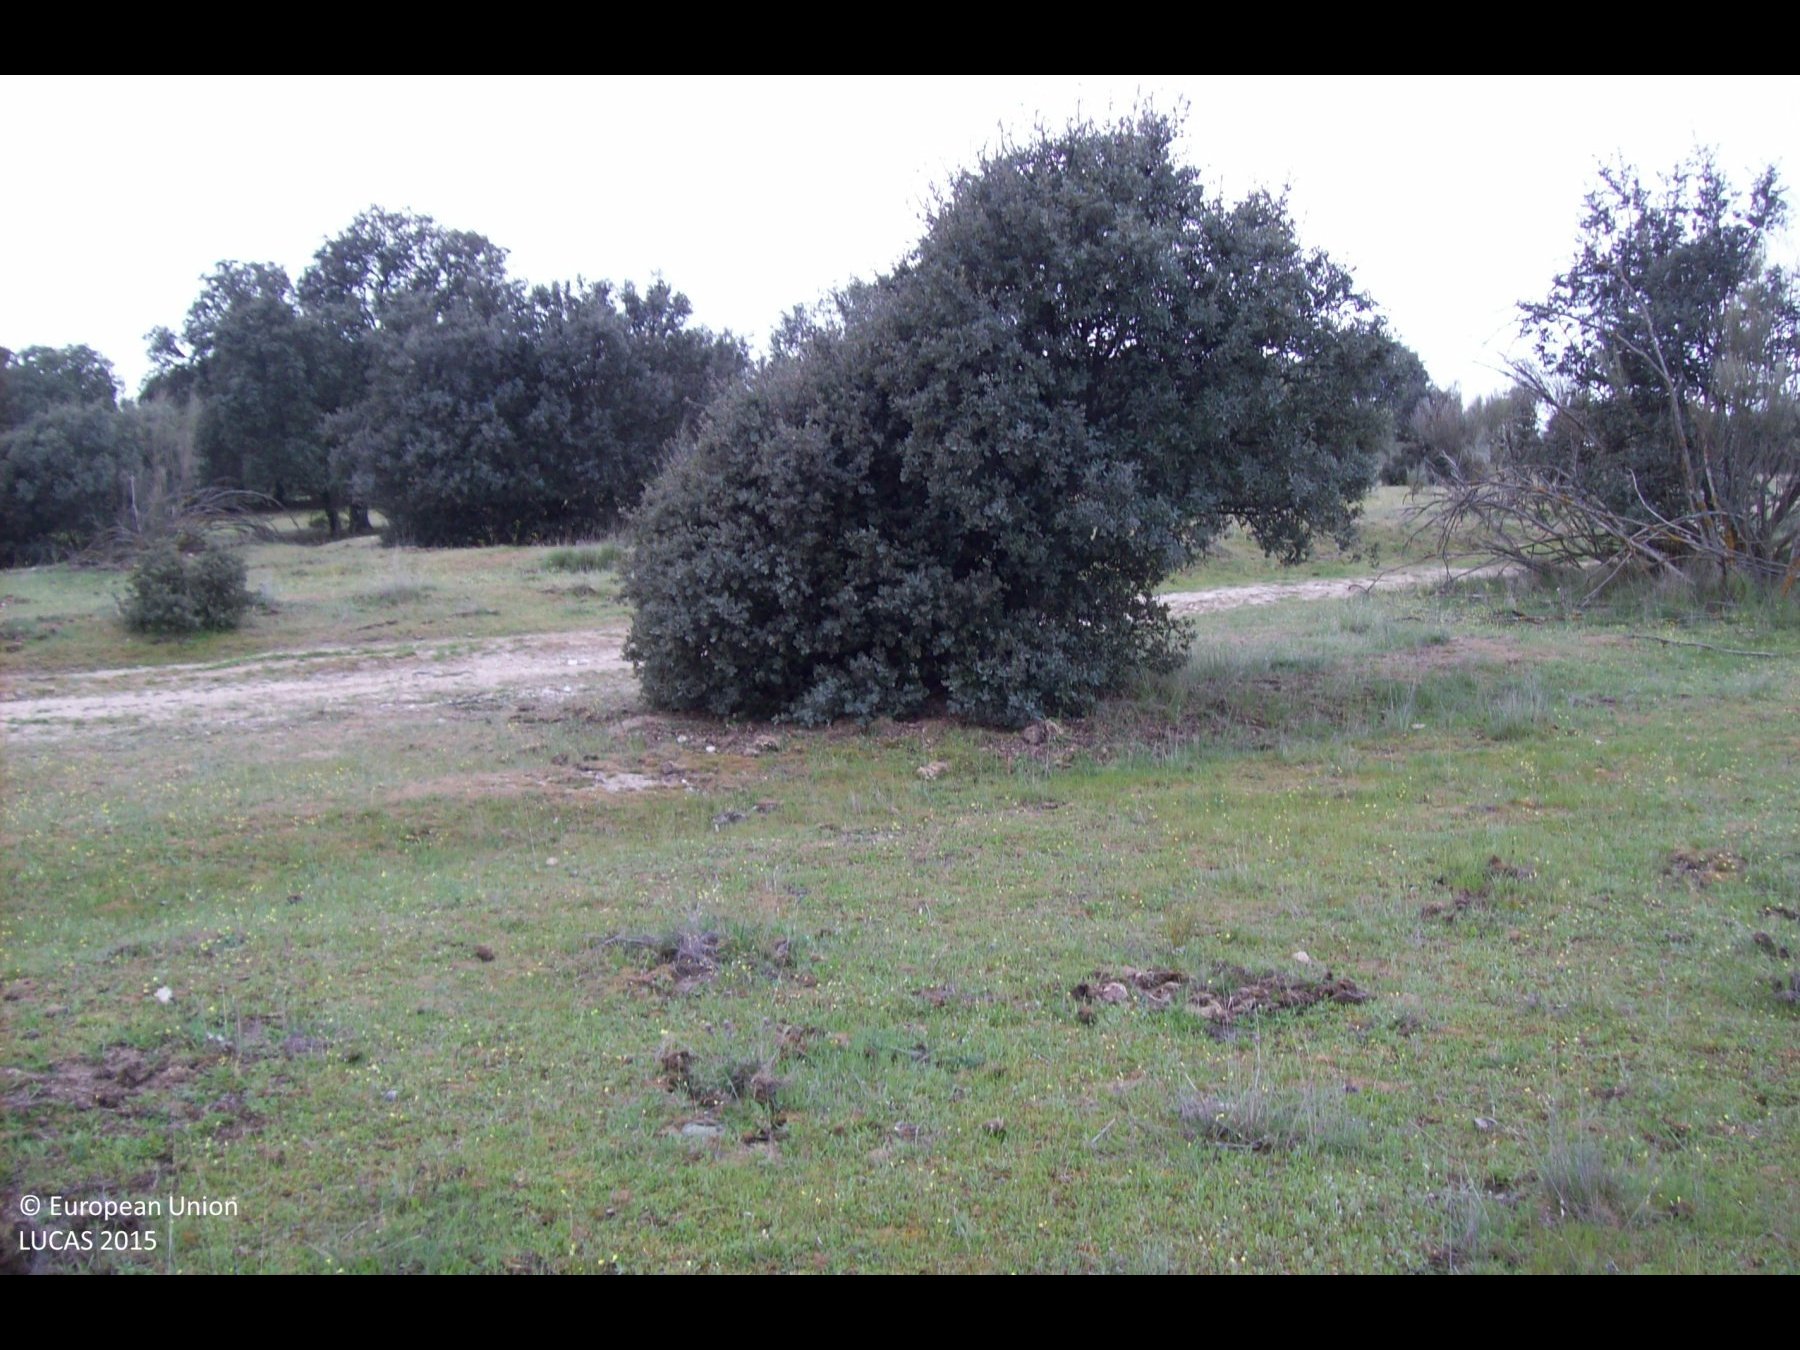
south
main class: Grassland
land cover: Grassland with sparse tree/shrub cover
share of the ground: > 75 %
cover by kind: herbaceous plants 85 %, broadleaved forest trees 5 %, shrubs 5 %
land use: Semi-natural and natural areas not in use
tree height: < 5 m
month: April
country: ES
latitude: 40.5415
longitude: -3.8675
